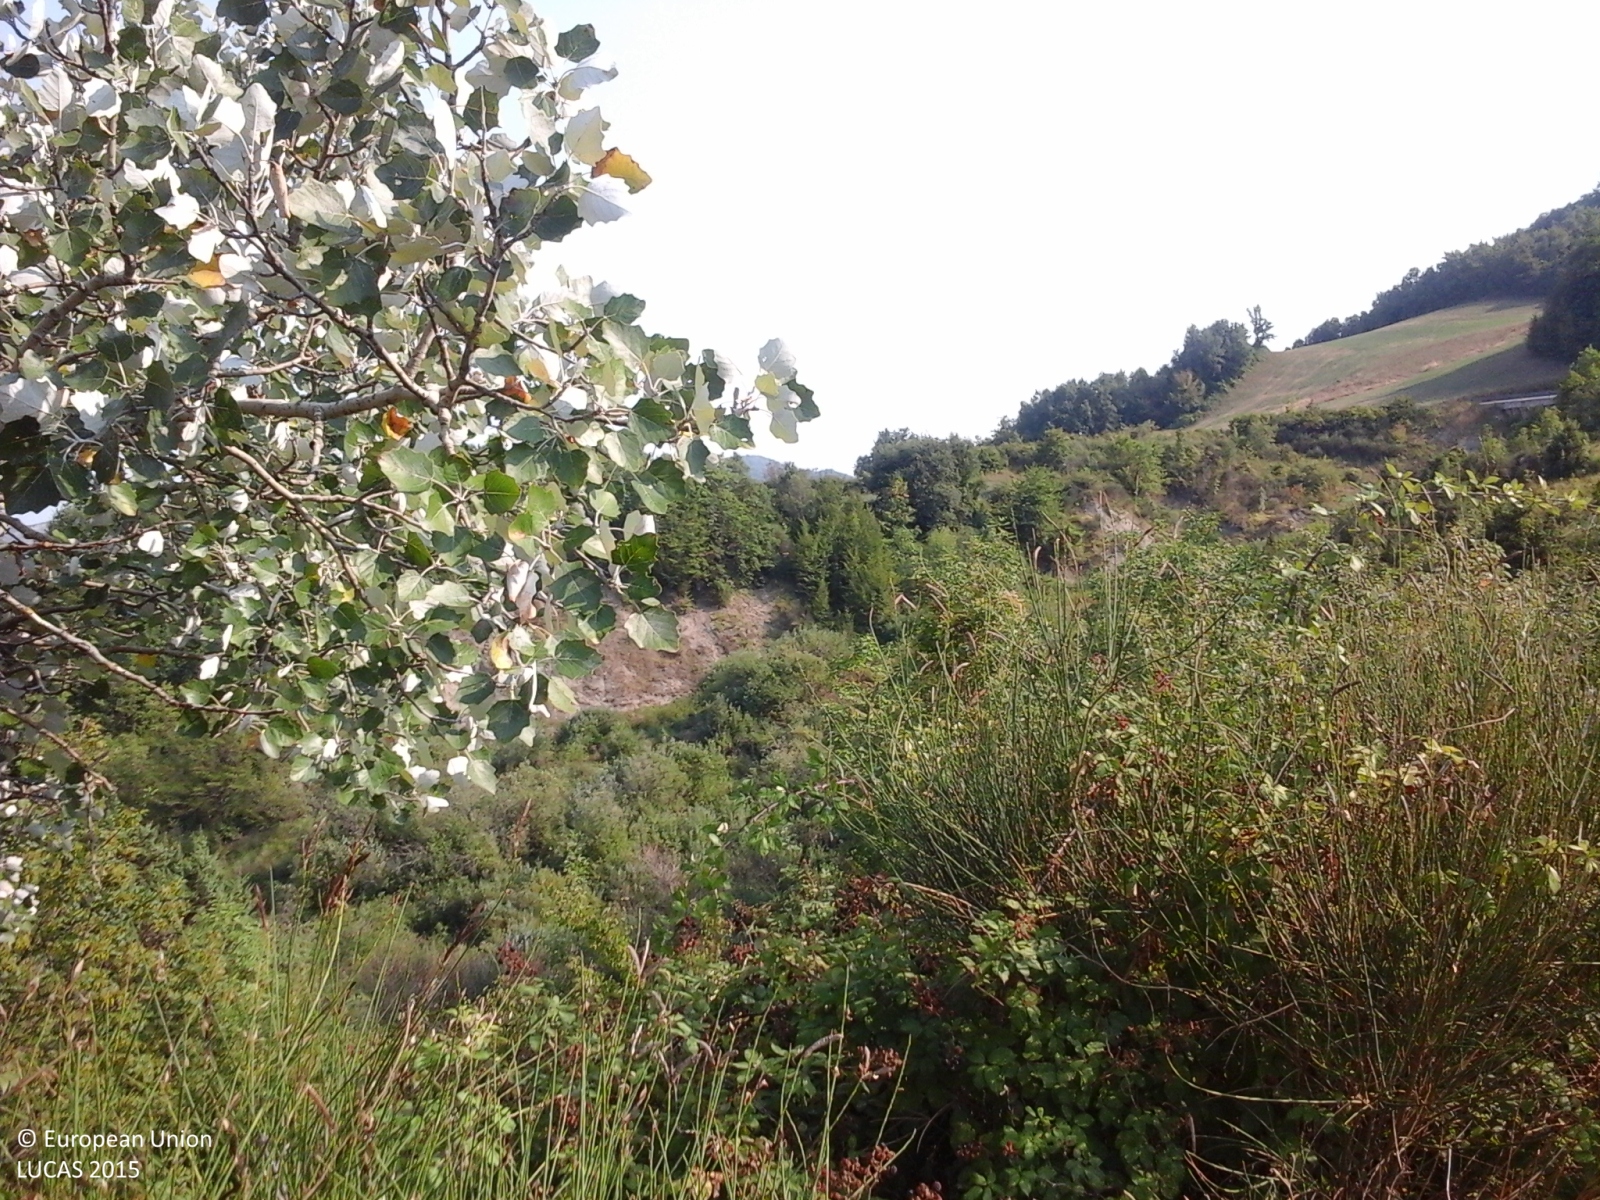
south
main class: Shrubland
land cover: Shrubland with sparse tree cover
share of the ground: > 75 %
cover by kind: shrubs 95 %, broadleaved forest trees 5 %
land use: Semi-natural and natural areas not in use
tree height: < 5 m
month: August
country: IT
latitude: 43.7443
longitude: 12.4402
